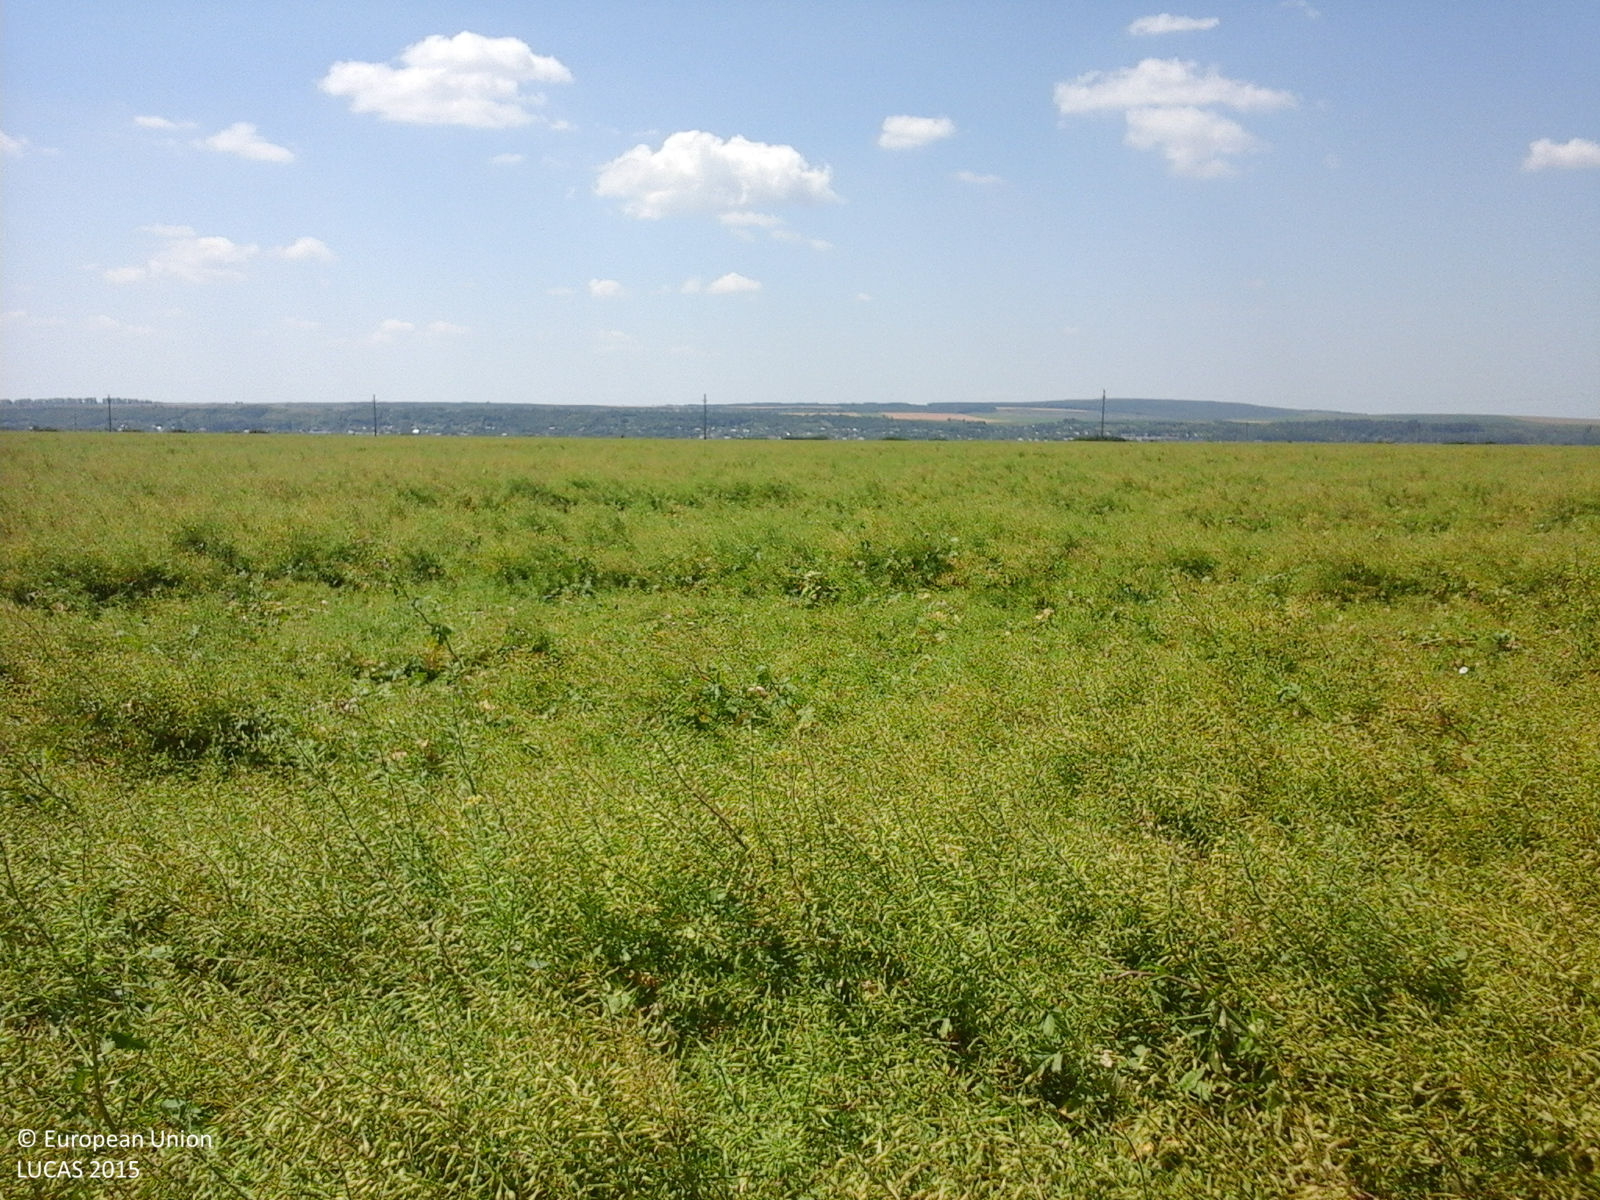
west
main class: Cropland
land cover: Rape and turnip rape
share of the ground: > 75 %
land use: Agriculture (excluding fallow land and kitchen gardens)
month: June
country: RO
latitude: 47.4090
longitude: 27.5459
